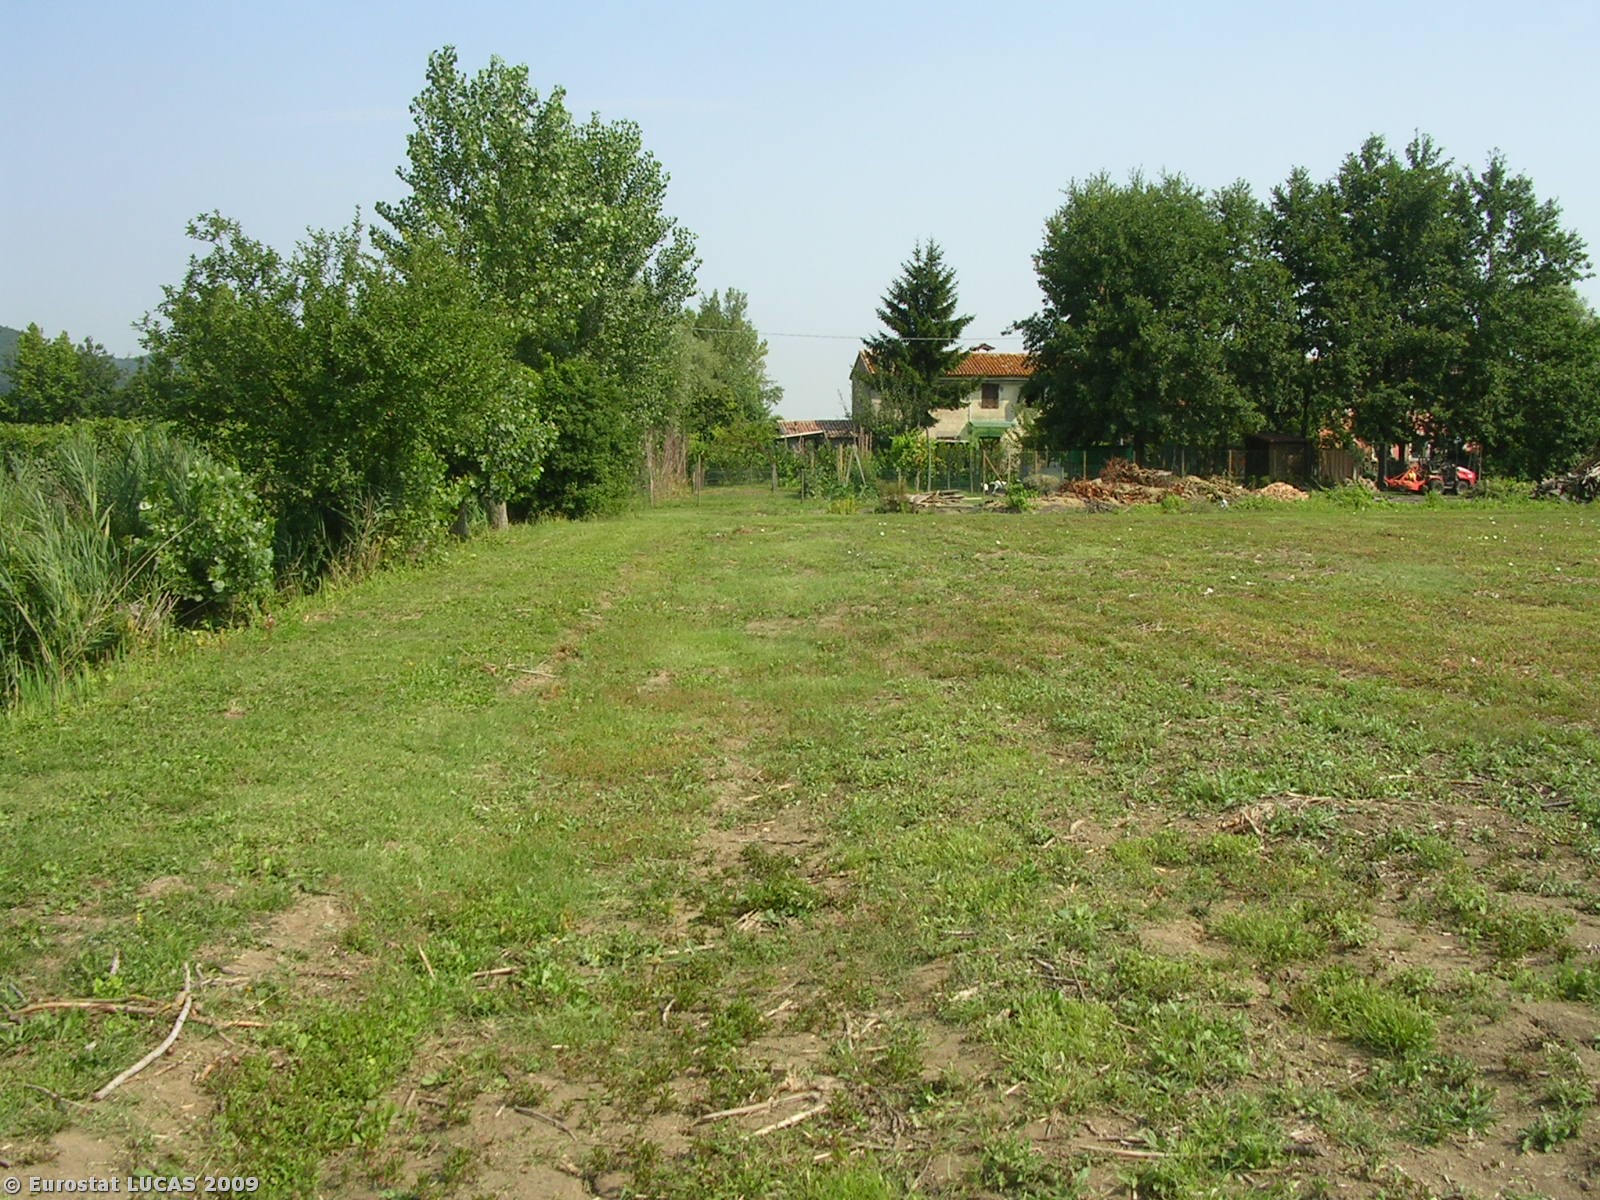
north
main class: Grassland
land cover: Grassland without tree/shrub cover
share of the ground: > 75 %
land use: Fallow land
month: July
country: IT
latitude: 45.3278
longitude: 11.7450
